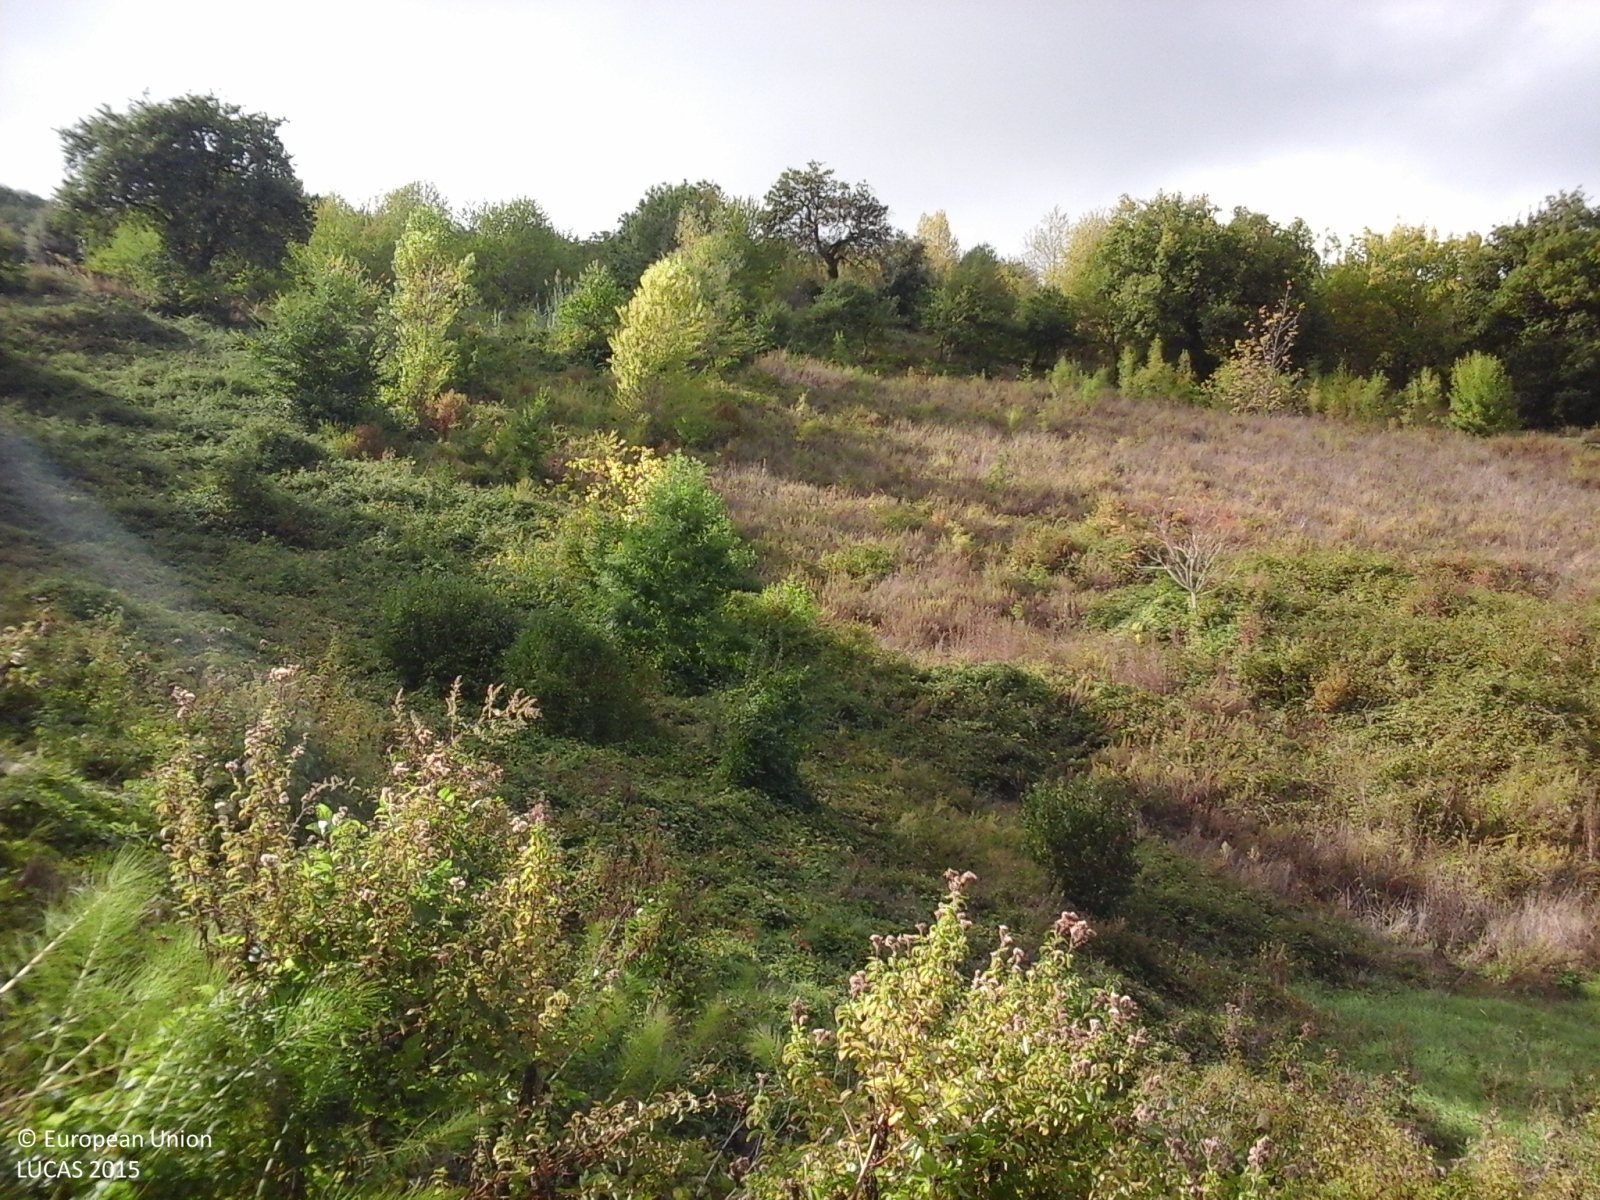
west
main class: Woodland
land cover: Broadleaved woodland
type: thermophilous deciduous forest
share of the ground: > 75 %
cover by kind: broadleaved forest trees 100 %
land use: Semi-natural and natural areas not in use
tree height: > 5 m
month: October
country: IT
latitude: 43.5522
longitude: 13.4699
